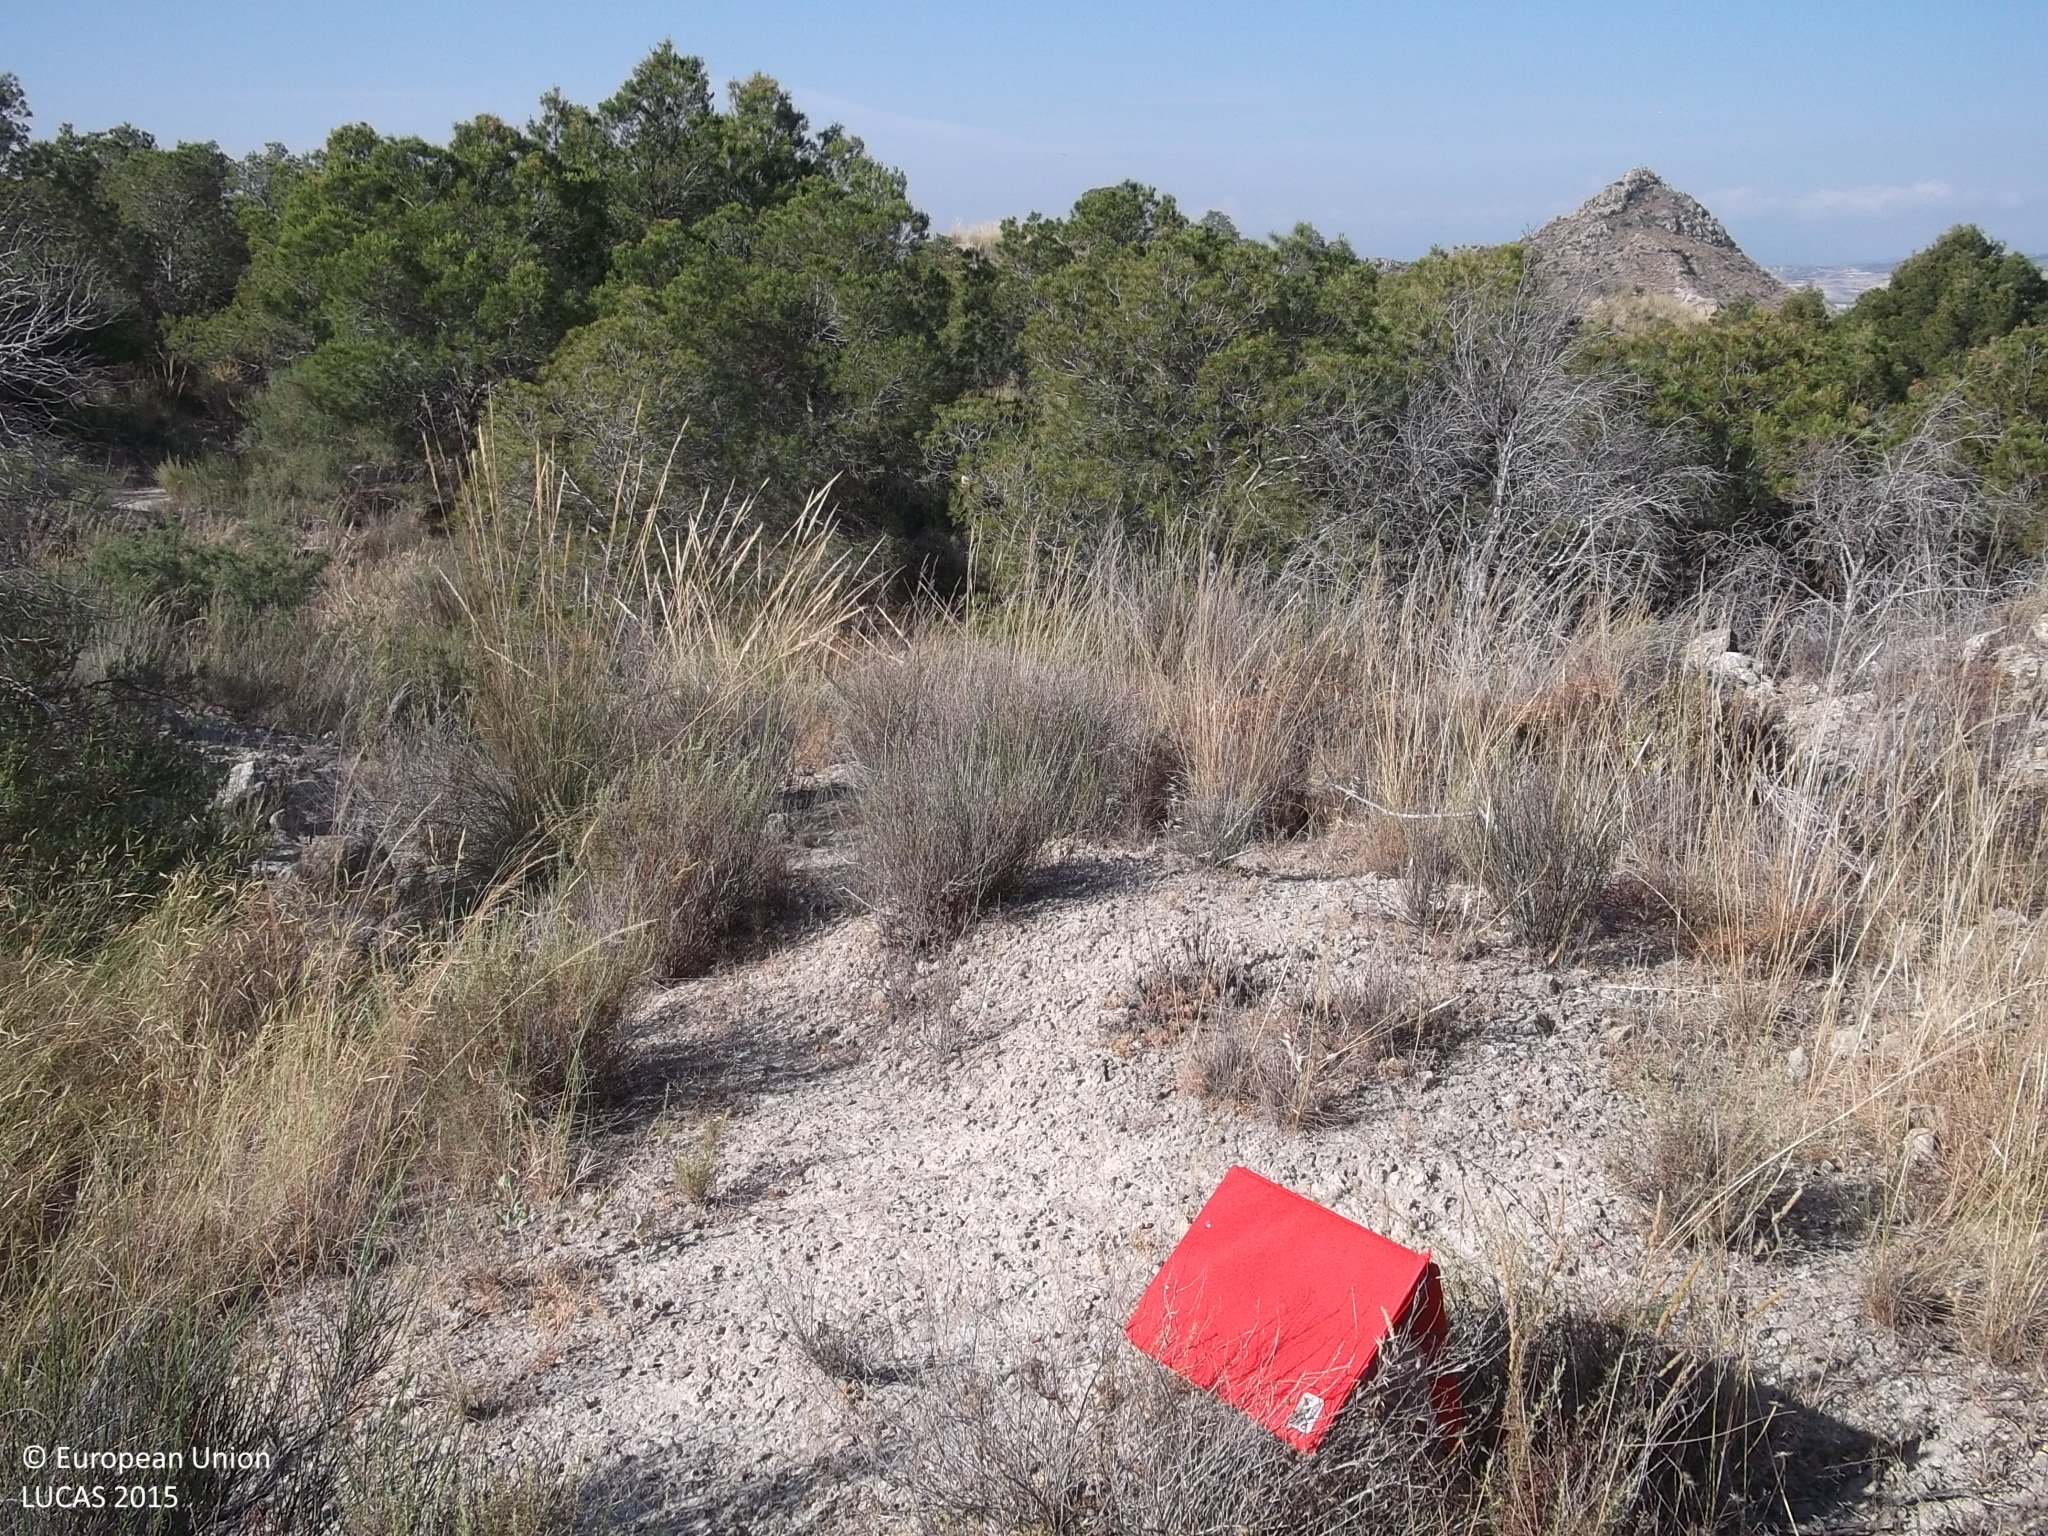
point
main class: Woodland
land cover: Pine dominated coniferous woodland
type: coniferous forest of the mediterranean region
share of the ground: 10 - 25 %
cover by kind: shrubs 30 %, herbaceous plants 30 %, consolidated bare surface 30 %, coniferous forest trees 10 %
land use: Semi-natural and natural areas not in use
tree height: < 5 m
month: May
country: ES
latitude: 38.1335
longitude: -1.2924
